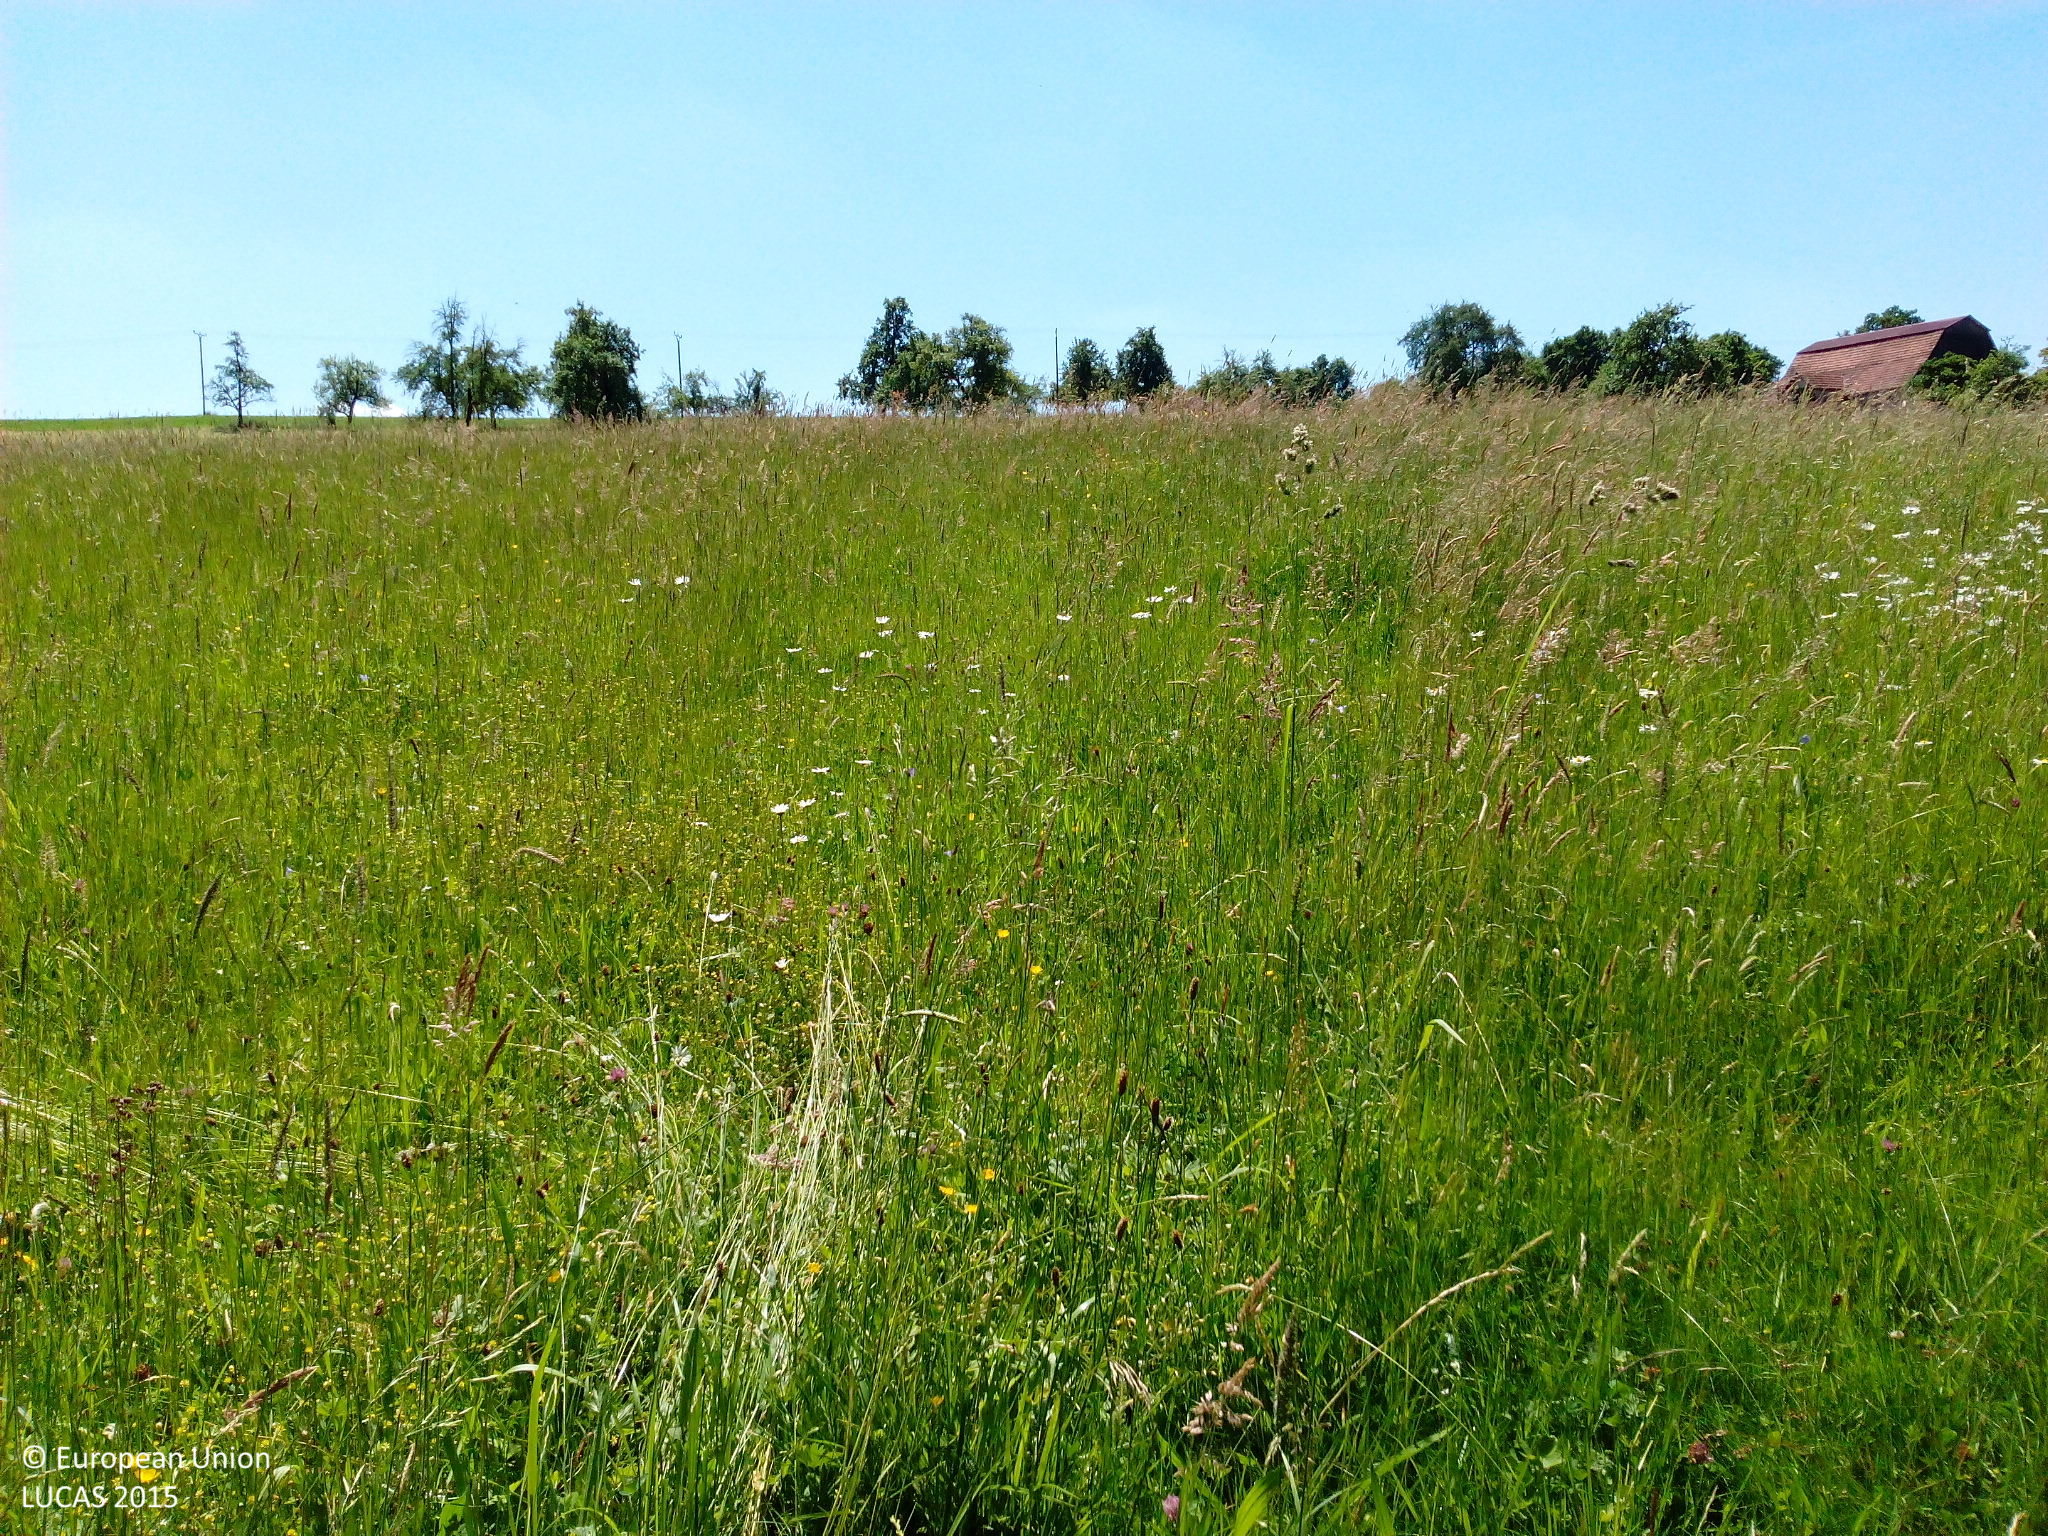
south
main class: Woodland
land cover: Spruce dominated mixed woodland
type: hemiboreal forest and nemoral coniferous forest and mixed broadleaved-coniferous forest
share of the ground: > 75 %
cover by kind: coniferous forest trees 65 %, broadleaved forest trees 35 %
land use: Forestry
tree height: < 5 m
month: June
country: DE
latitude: 48.9966
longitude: 9.6311
